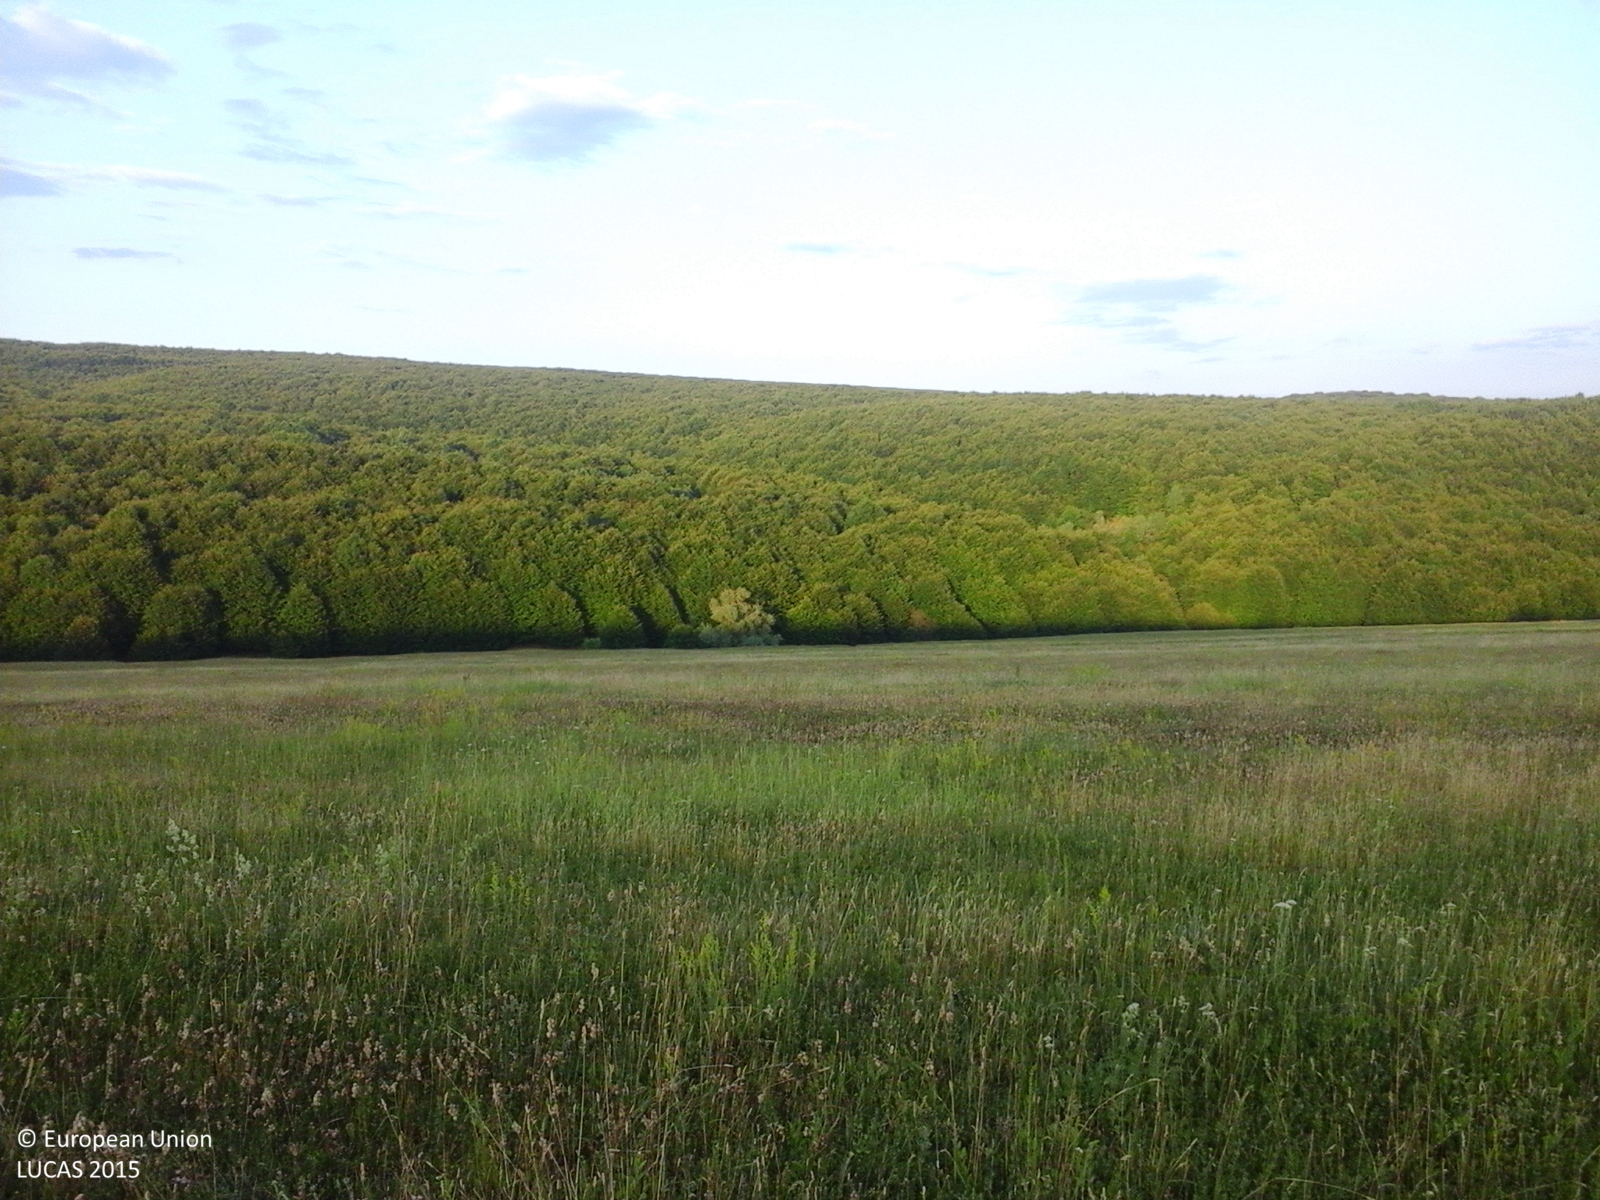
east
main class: Grassland
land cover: Grassland without tree/shrub cover
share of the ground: > 75 %
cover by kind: herbaceous plants 100 %
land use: Agriculture (excluding fallow land and kitchen gardens)
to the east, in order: Grassland without tree/shrub cover
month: June
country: RO
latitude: 47.4607
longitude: 26.5251
